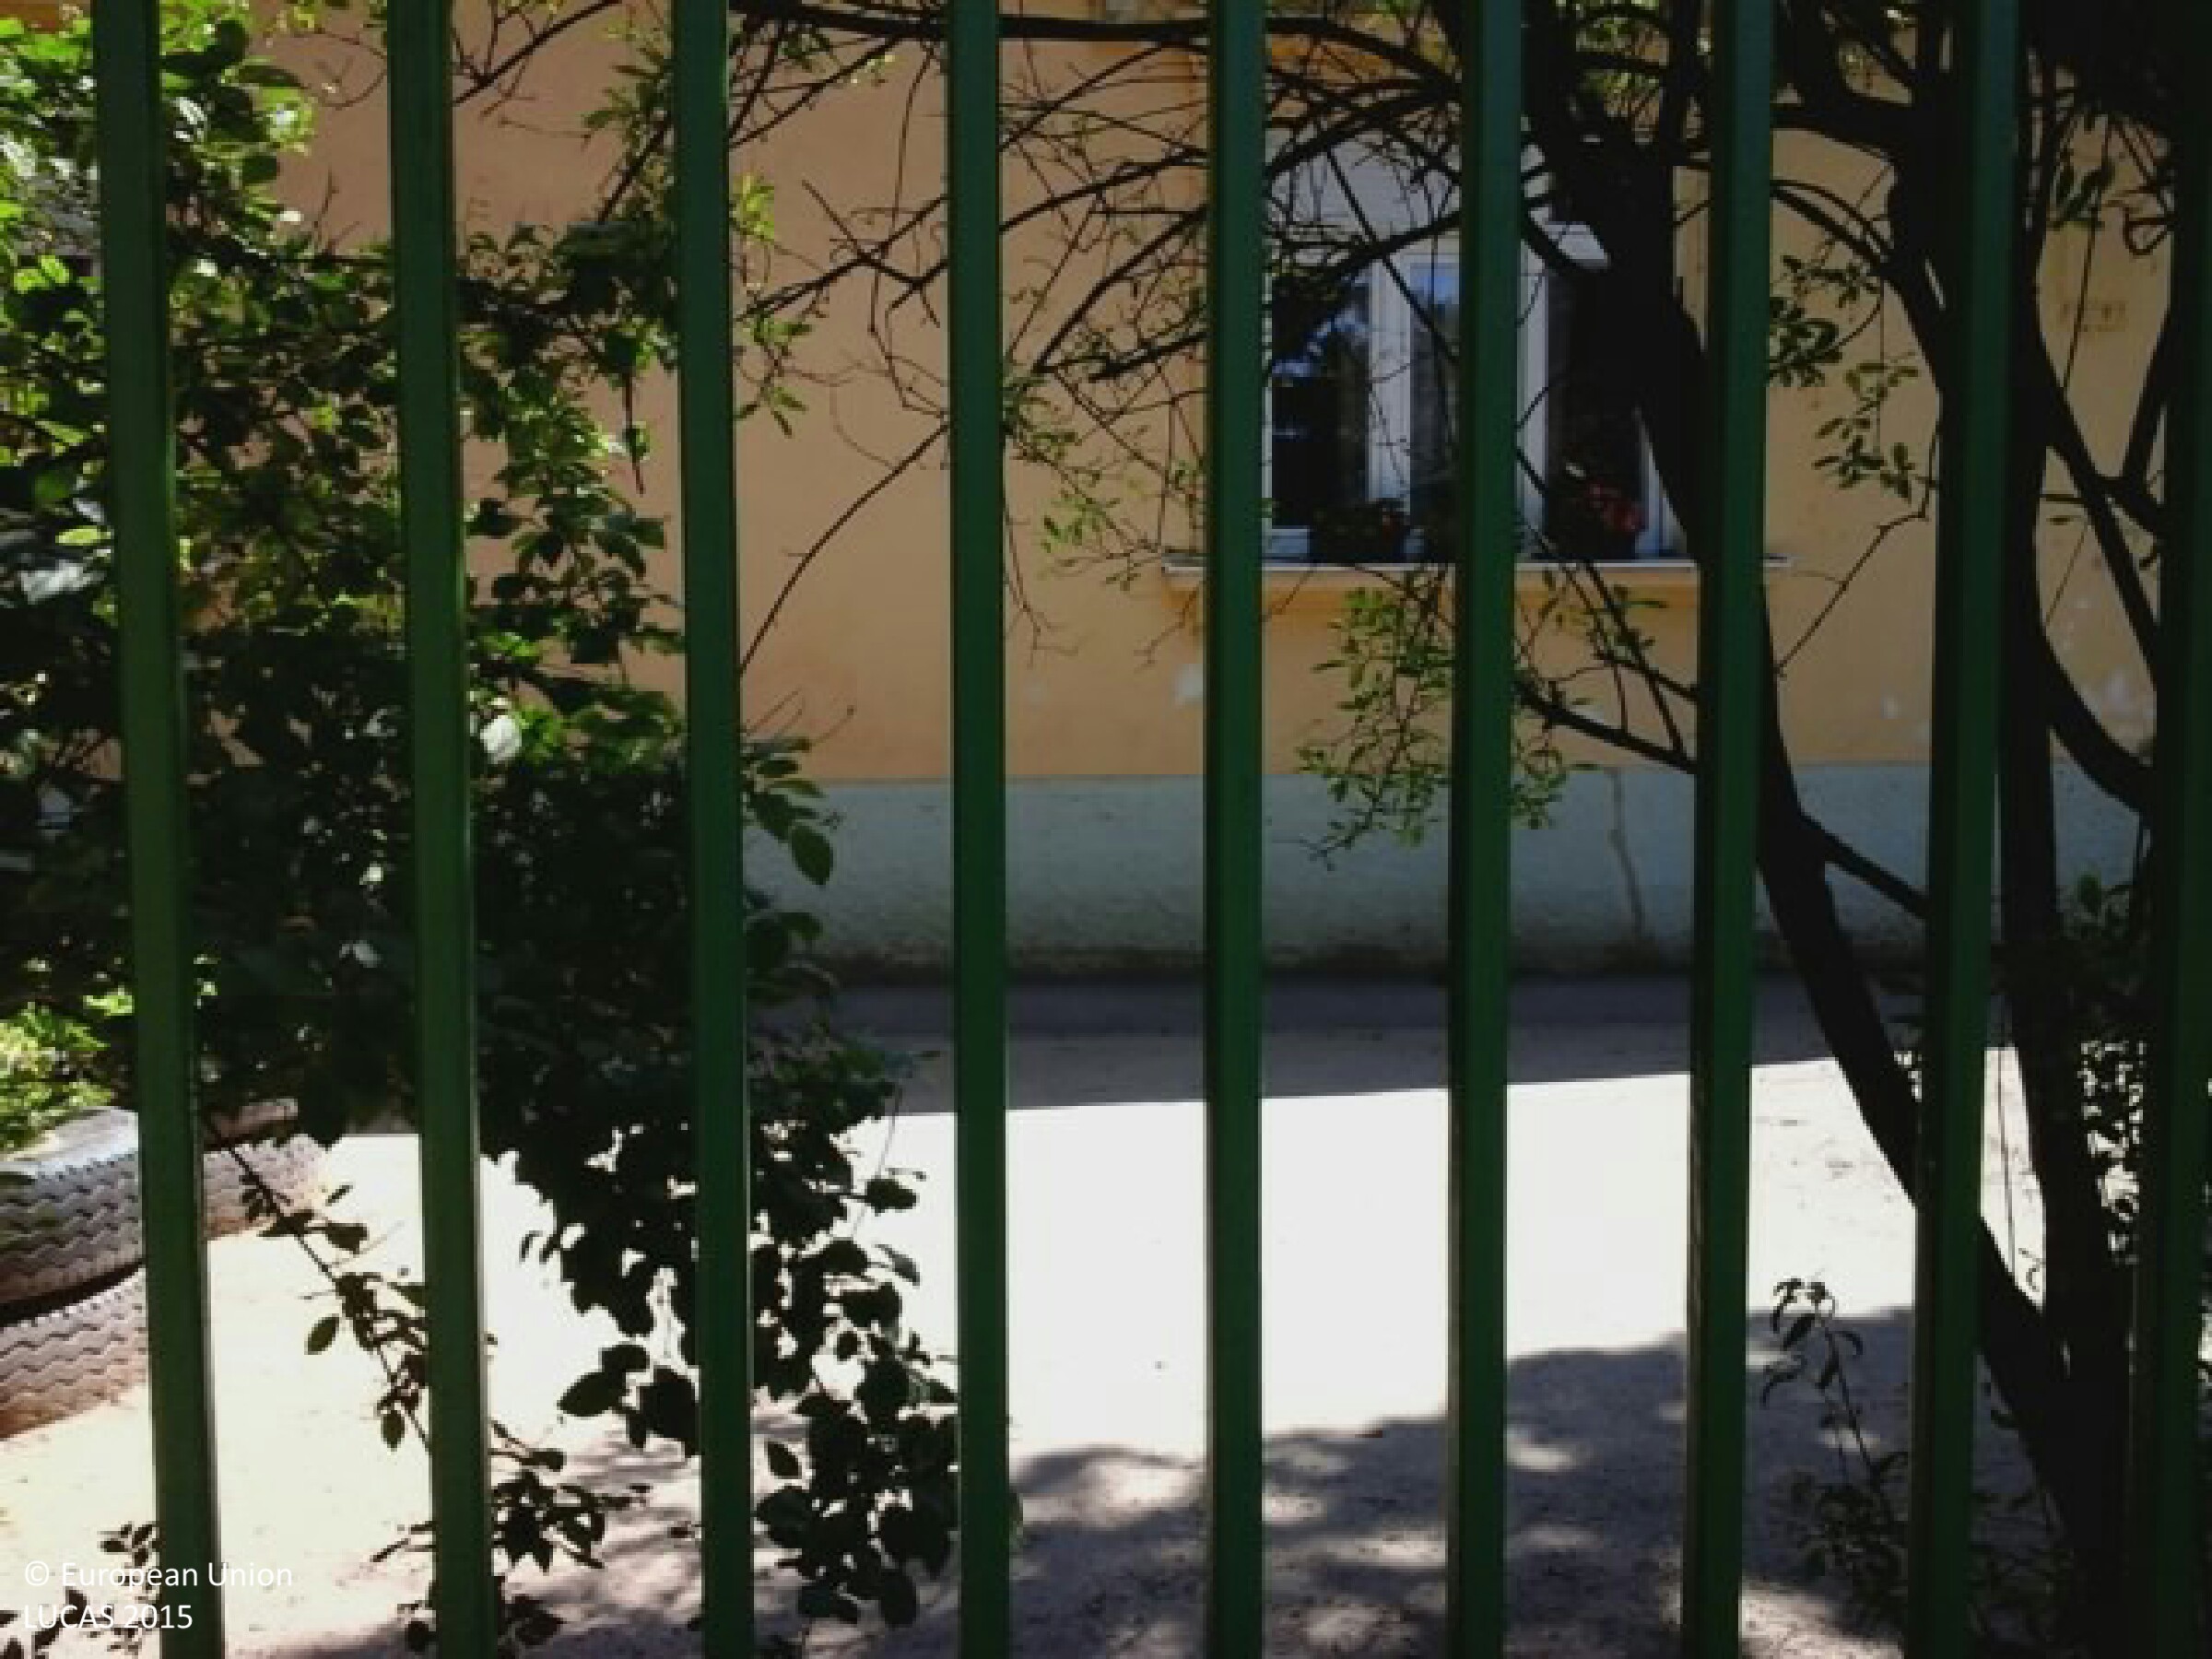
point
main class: Woodland
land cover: Broadleaved woodland
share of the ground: > 75 %
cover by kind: broadleaved forest trees 95 %, coniferous forest trees 5 %
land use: Community services
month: June
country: HU
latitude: 47.4881
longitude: 19.2702
